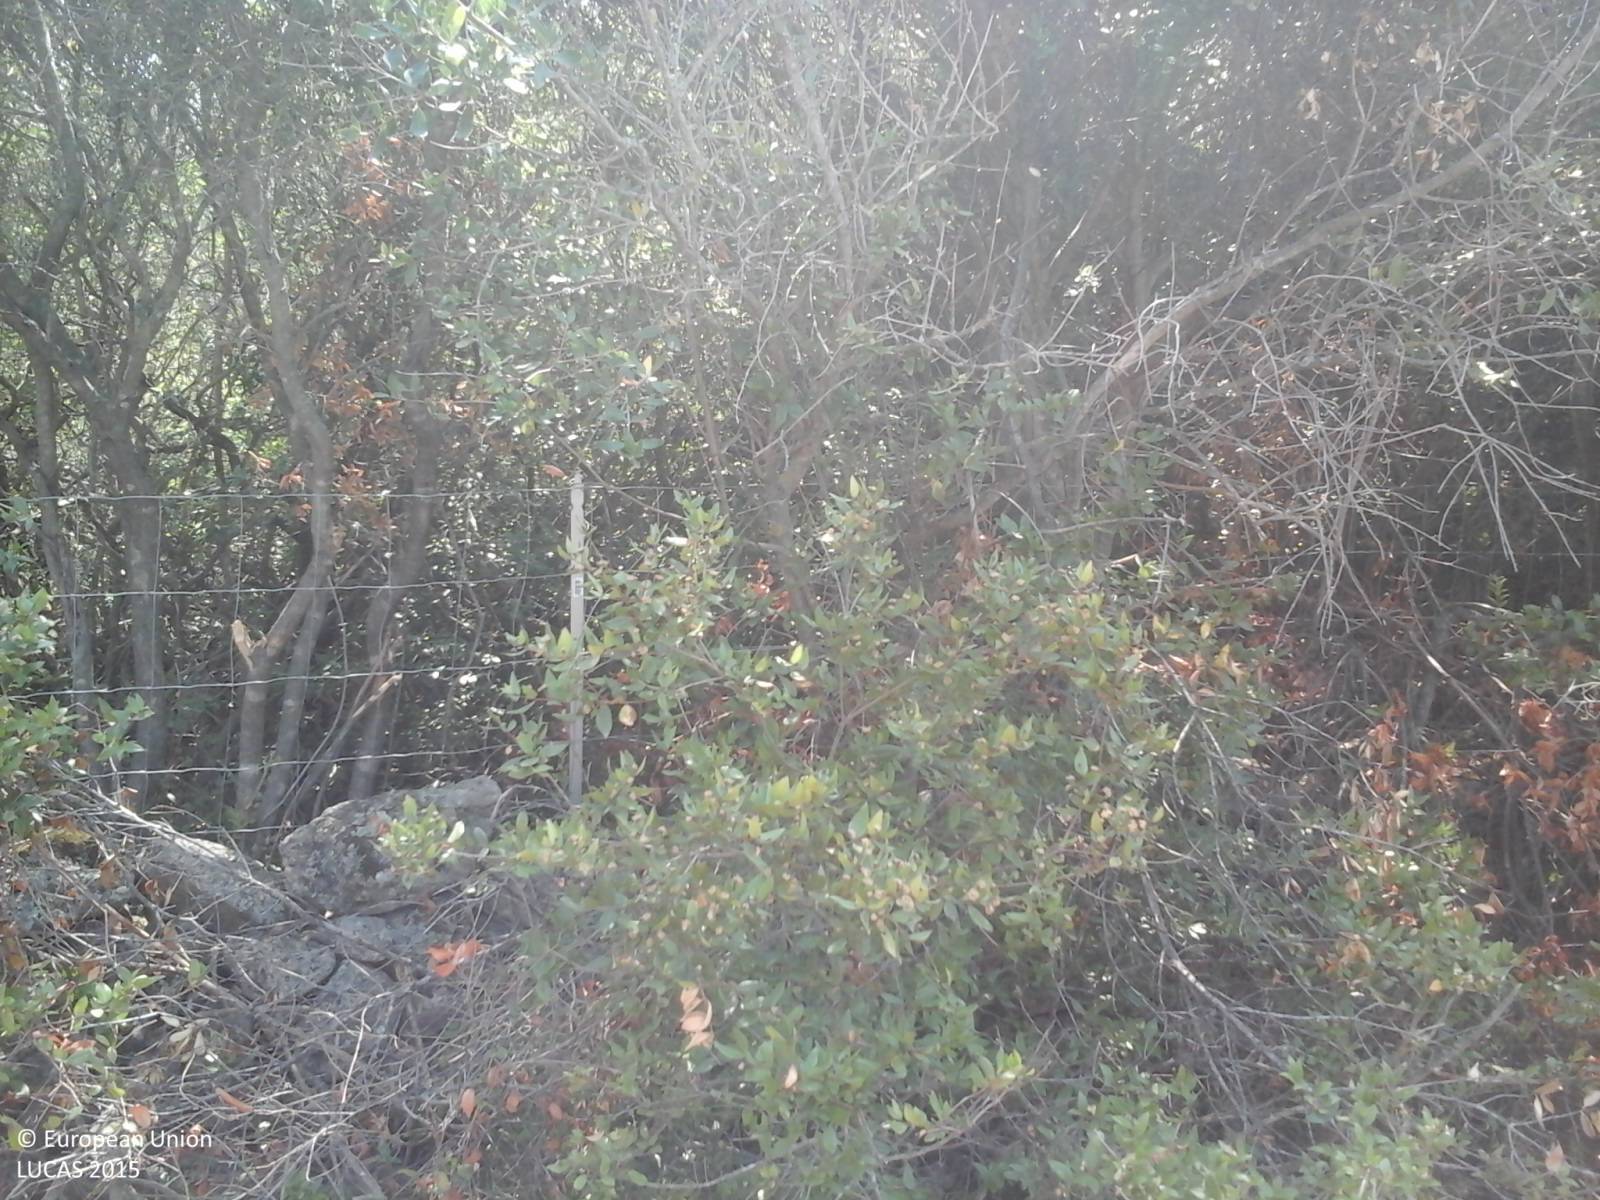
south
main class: Woodland
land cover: Broadleaved woodland
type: broadleaved evergreen forest
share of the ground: > 75 %
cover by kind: broadleaved forest trees 95 %, shrubs 5 %
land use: Forestry
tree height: > 5 m
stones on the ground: 10 - 25 %
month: July
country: IT
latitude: 40.7367
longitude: 9.5168
